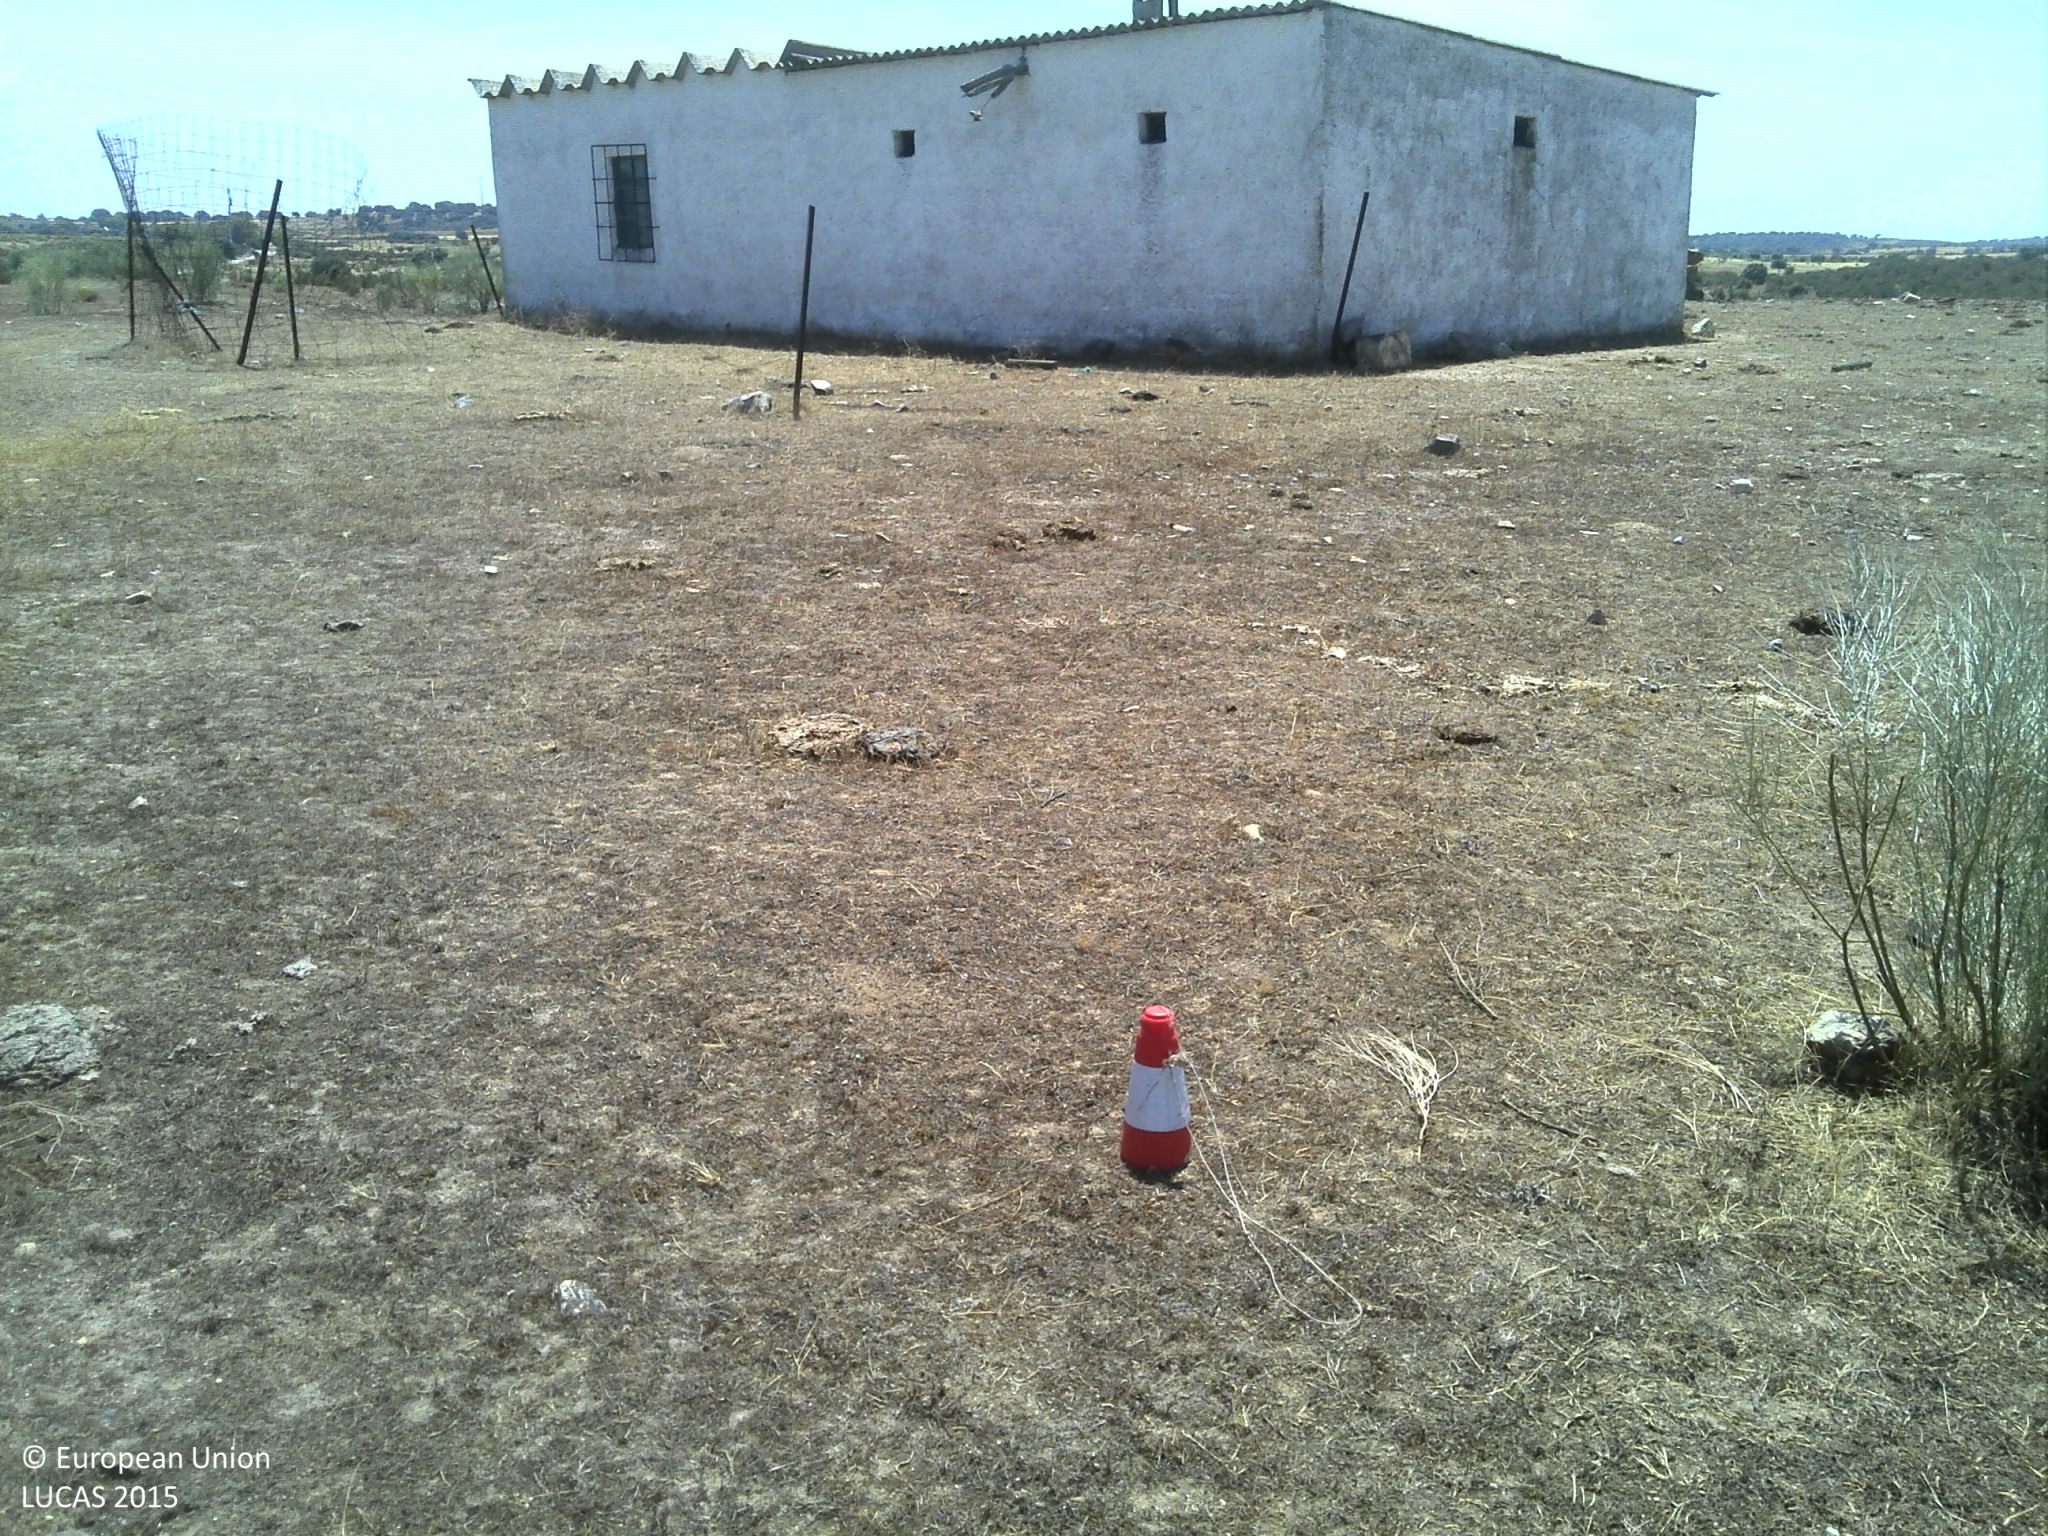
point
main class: Grassland
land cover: Grassland without tree/shrub cover
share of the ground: 10 - 25 %
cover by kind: unconsolidated bare surface 70 %, herbaceous plants 25 %
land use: Agriculture (excluding fallow land and kitchen gardens)
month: June
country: PT
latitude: 39.8387
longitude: -7.1166
